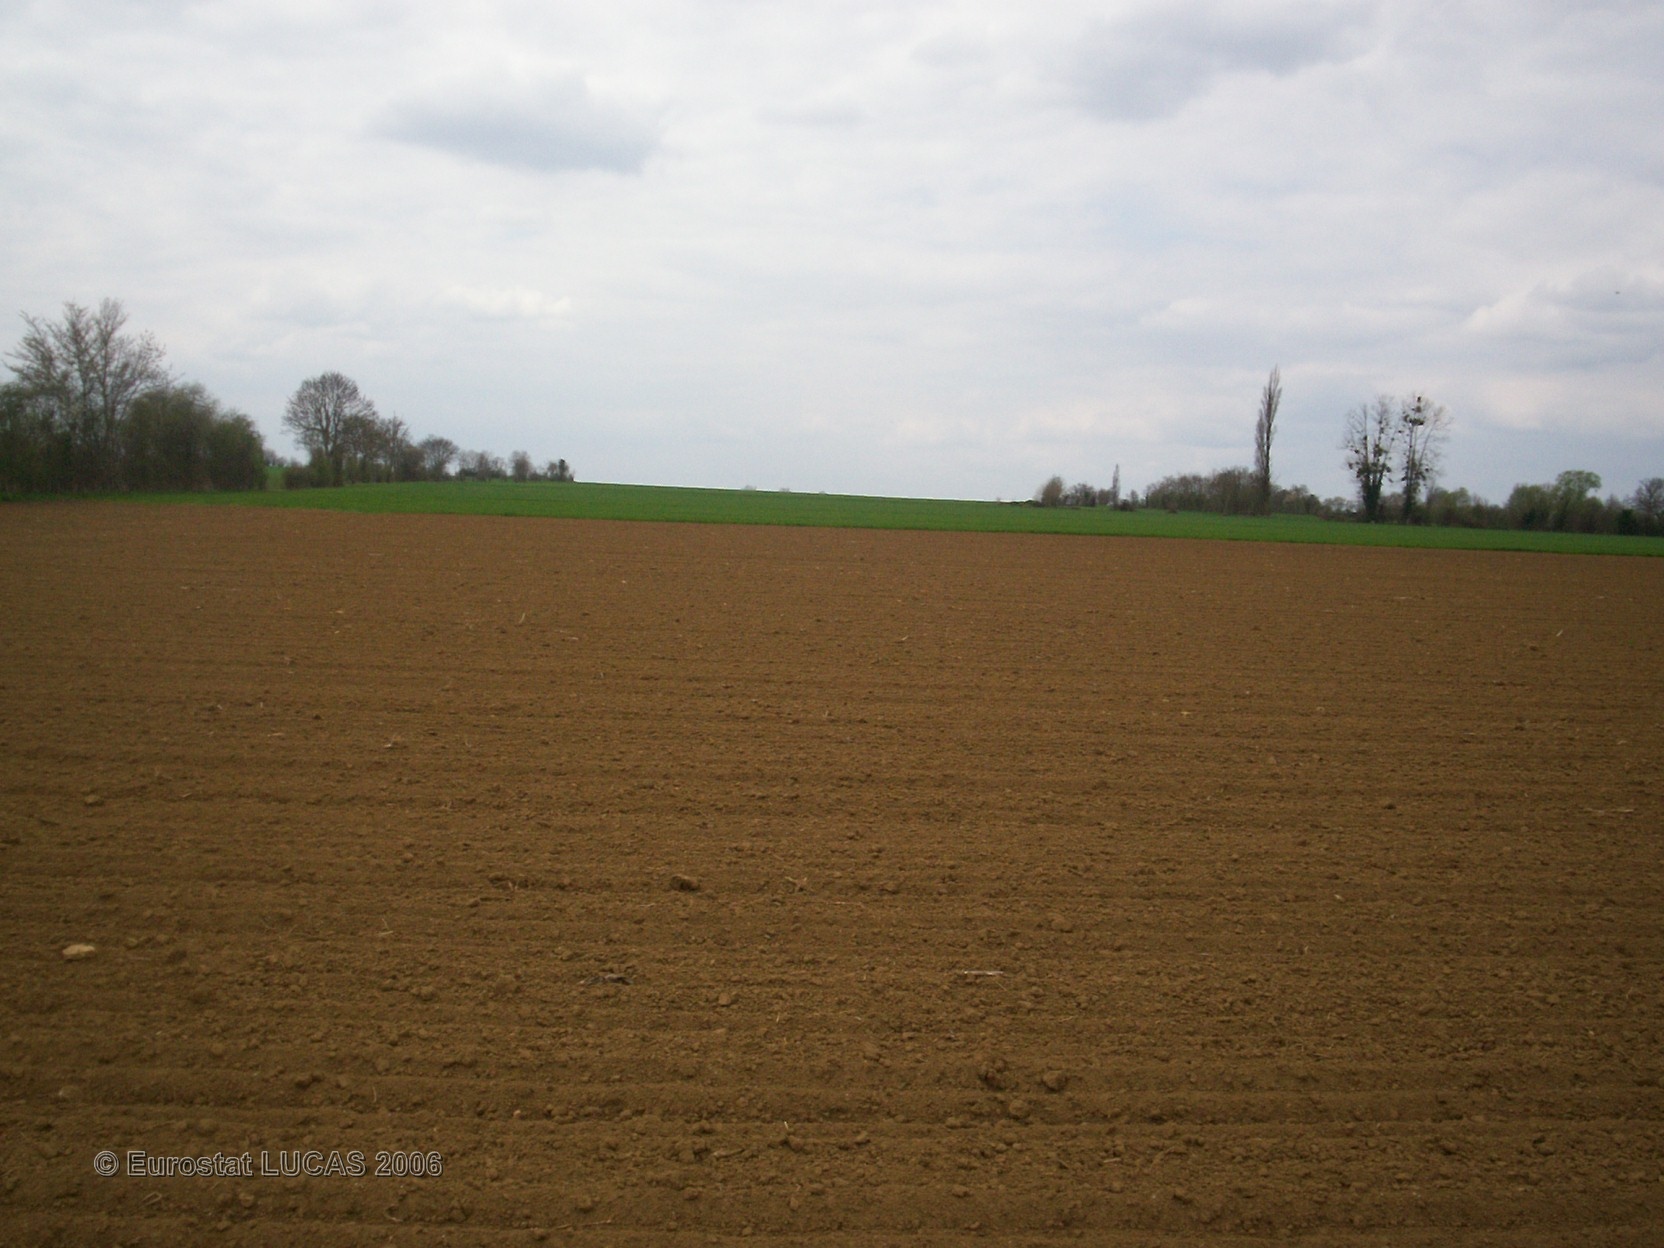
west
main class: Cropland
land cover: Sugar beet
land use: Agriculture (excluding fallow land and kitchen gardens)
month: April
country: FR
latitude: 48.9653
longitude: 0.0118
